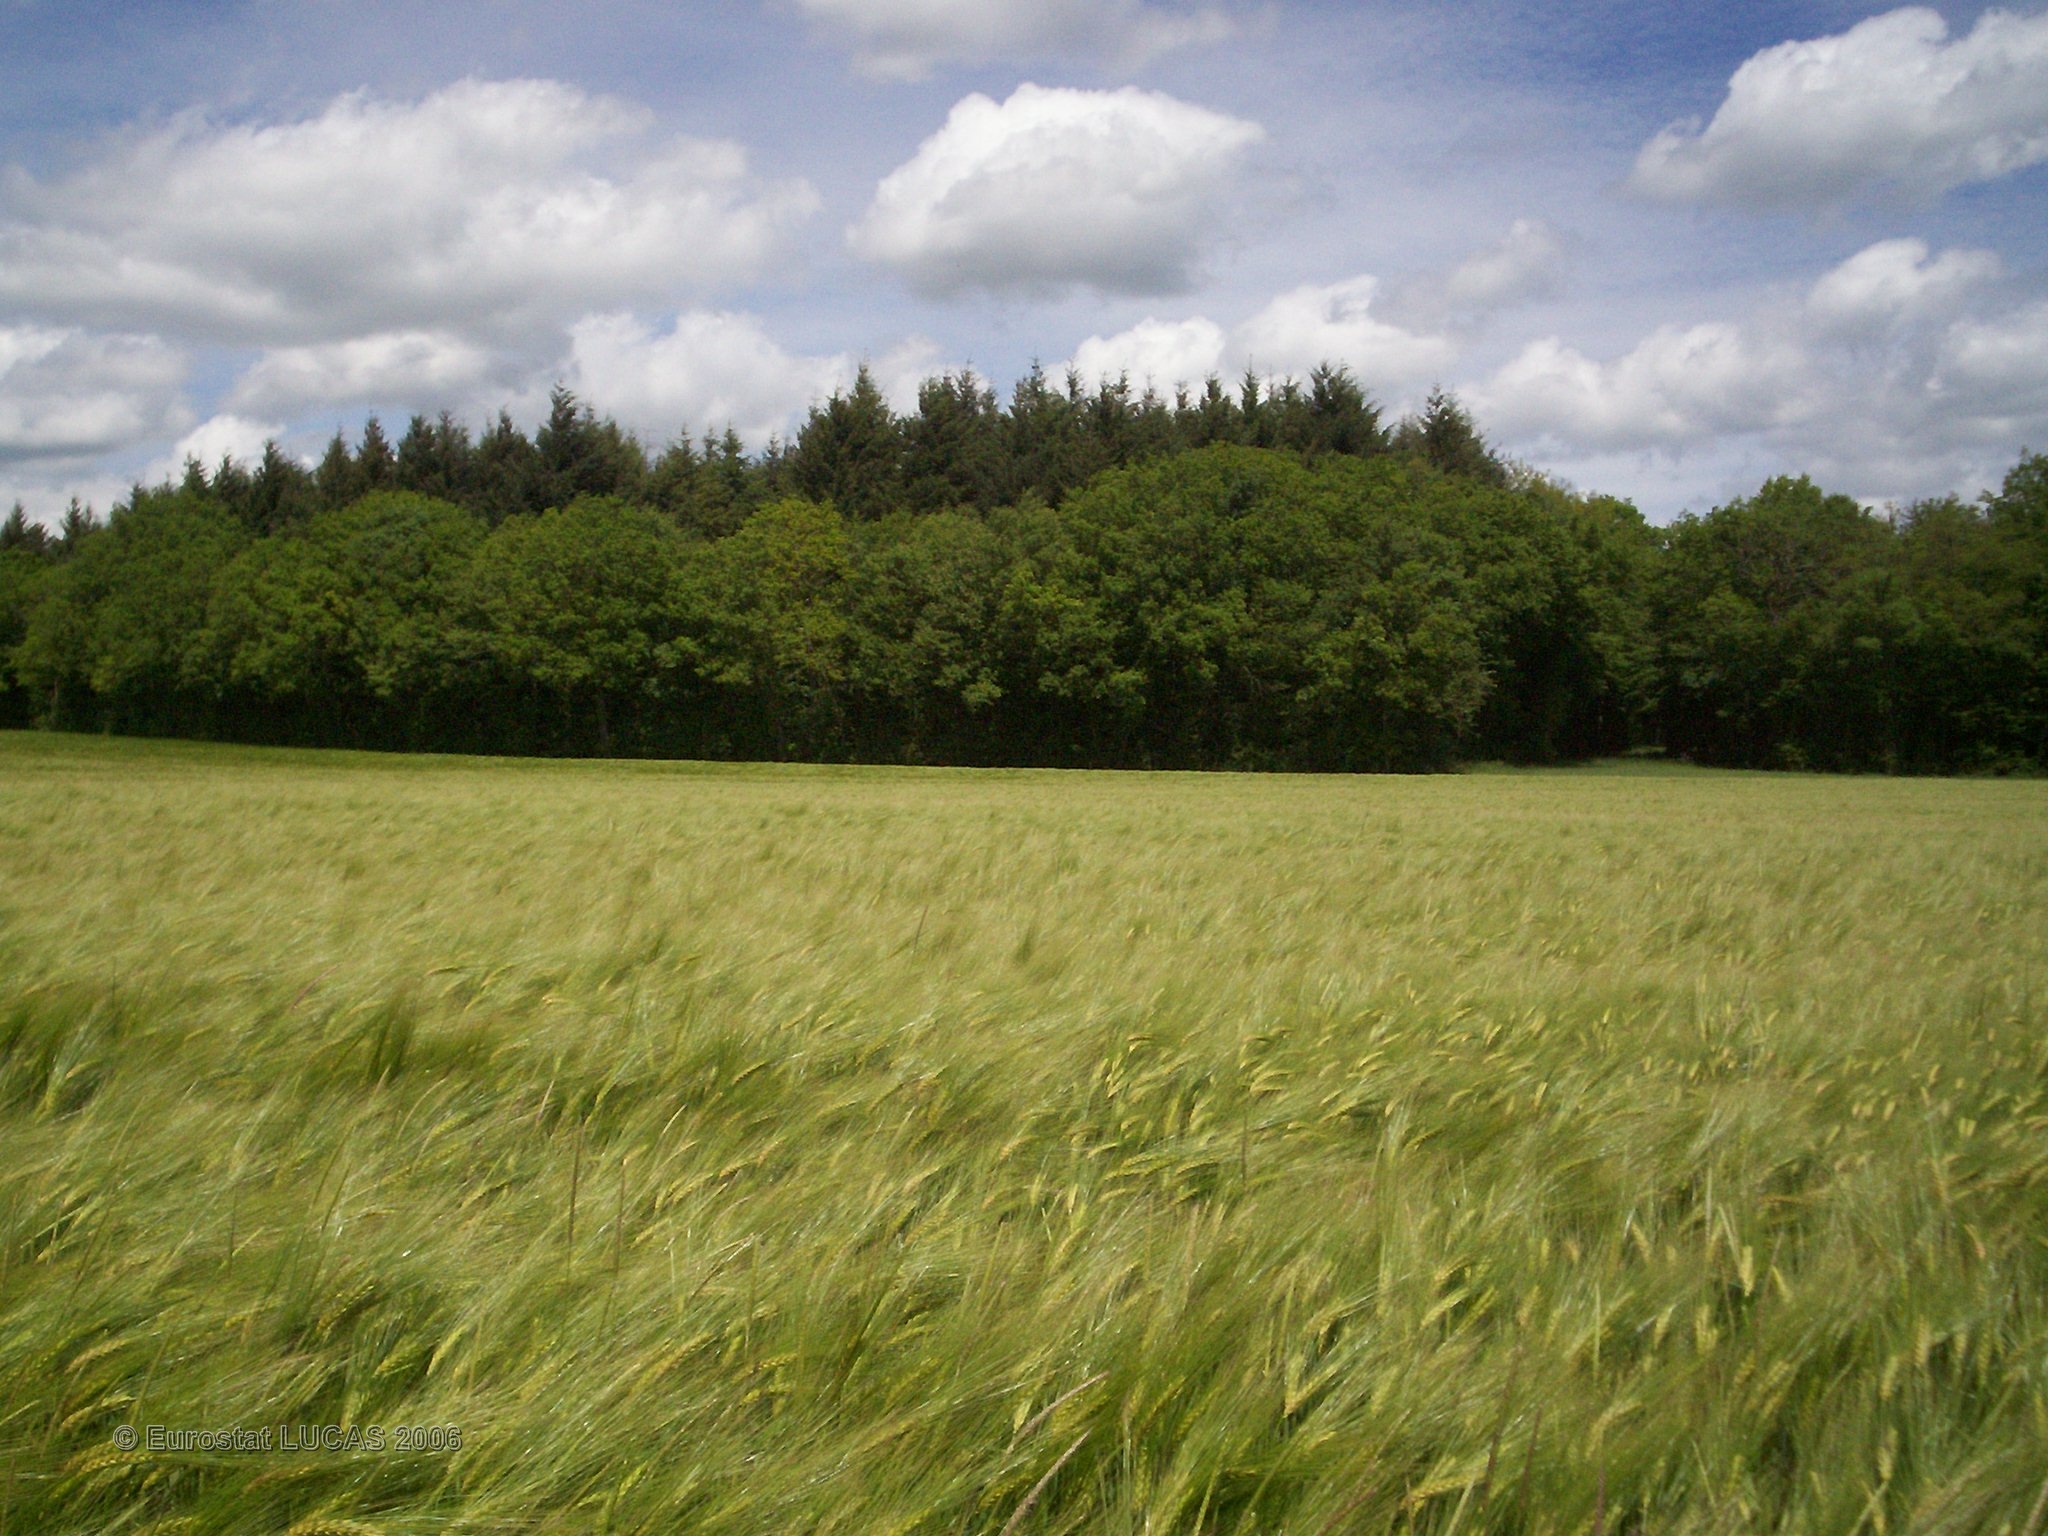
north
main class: Cropland
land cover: Barley
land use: Agriculture (excluding fallow land and kitchen gardens)
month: May
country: FR
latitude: 47.5953
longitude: 4.0797
